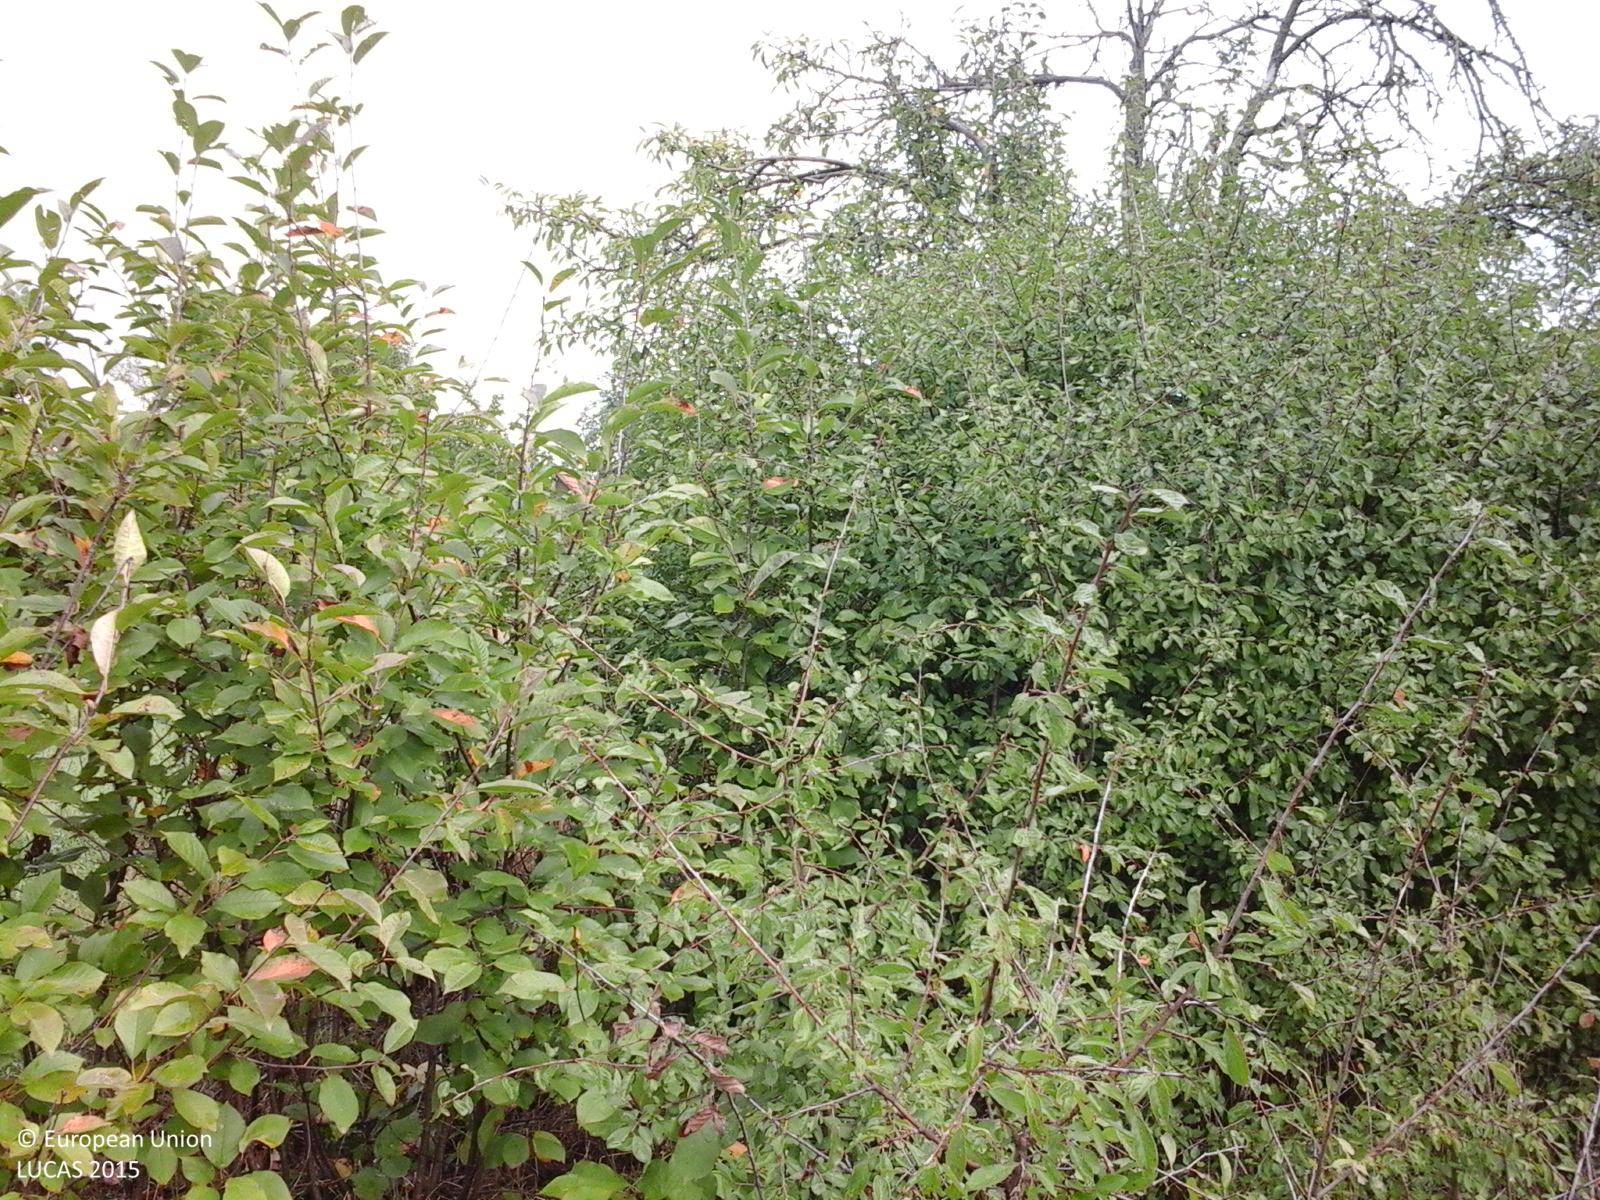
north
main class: Grassland
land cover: Grassland with sparse tree/shrub cover
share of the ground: > 75 %
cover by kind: herbaceous plants 85 %, shrubs 10 %, broadleaved forest trees 5 %
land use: Agriculture (excluding fallow land and kitchen gardens)
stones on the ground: < 10 %
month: September
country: RO
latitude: 46.7168
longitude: 21.7773
